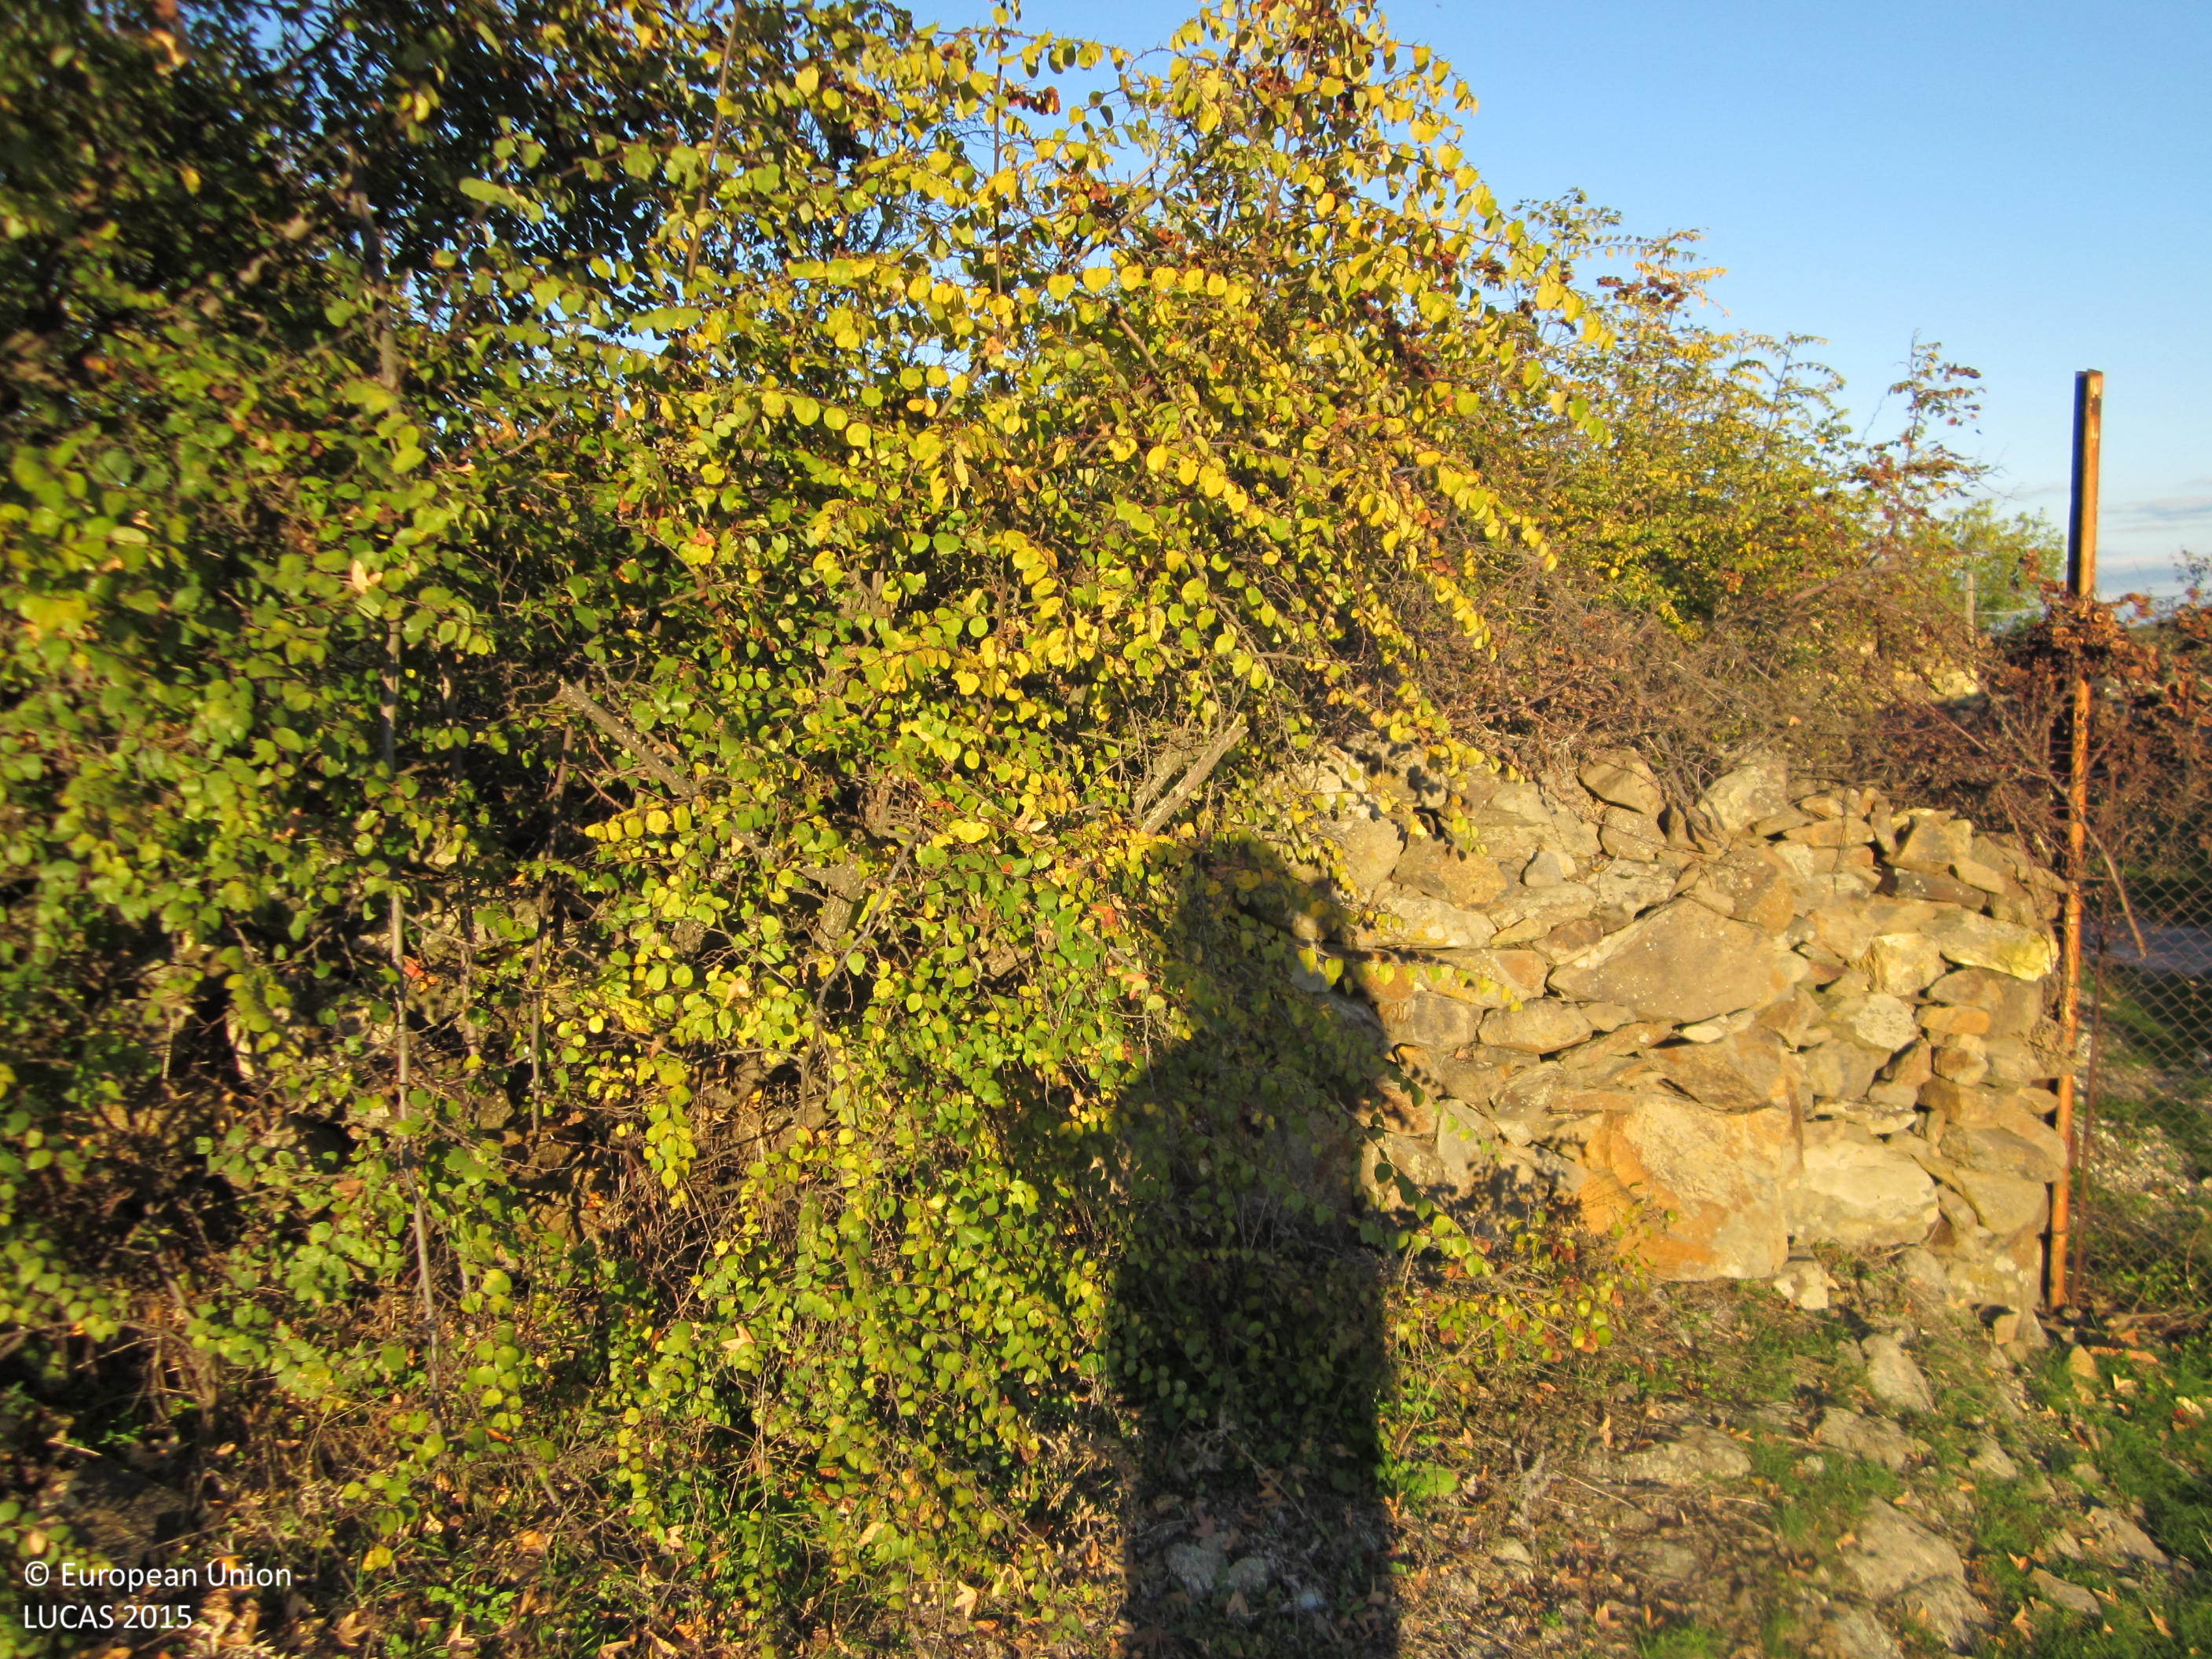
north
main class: Grassland
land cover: Grassland without tree/shrub cover
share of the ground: 50 - 75 %
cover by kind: herbaceous plants 50 %, shrubs 5 %
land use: Residential
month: October
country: BG
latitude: 41.4610
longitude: 25.5623
